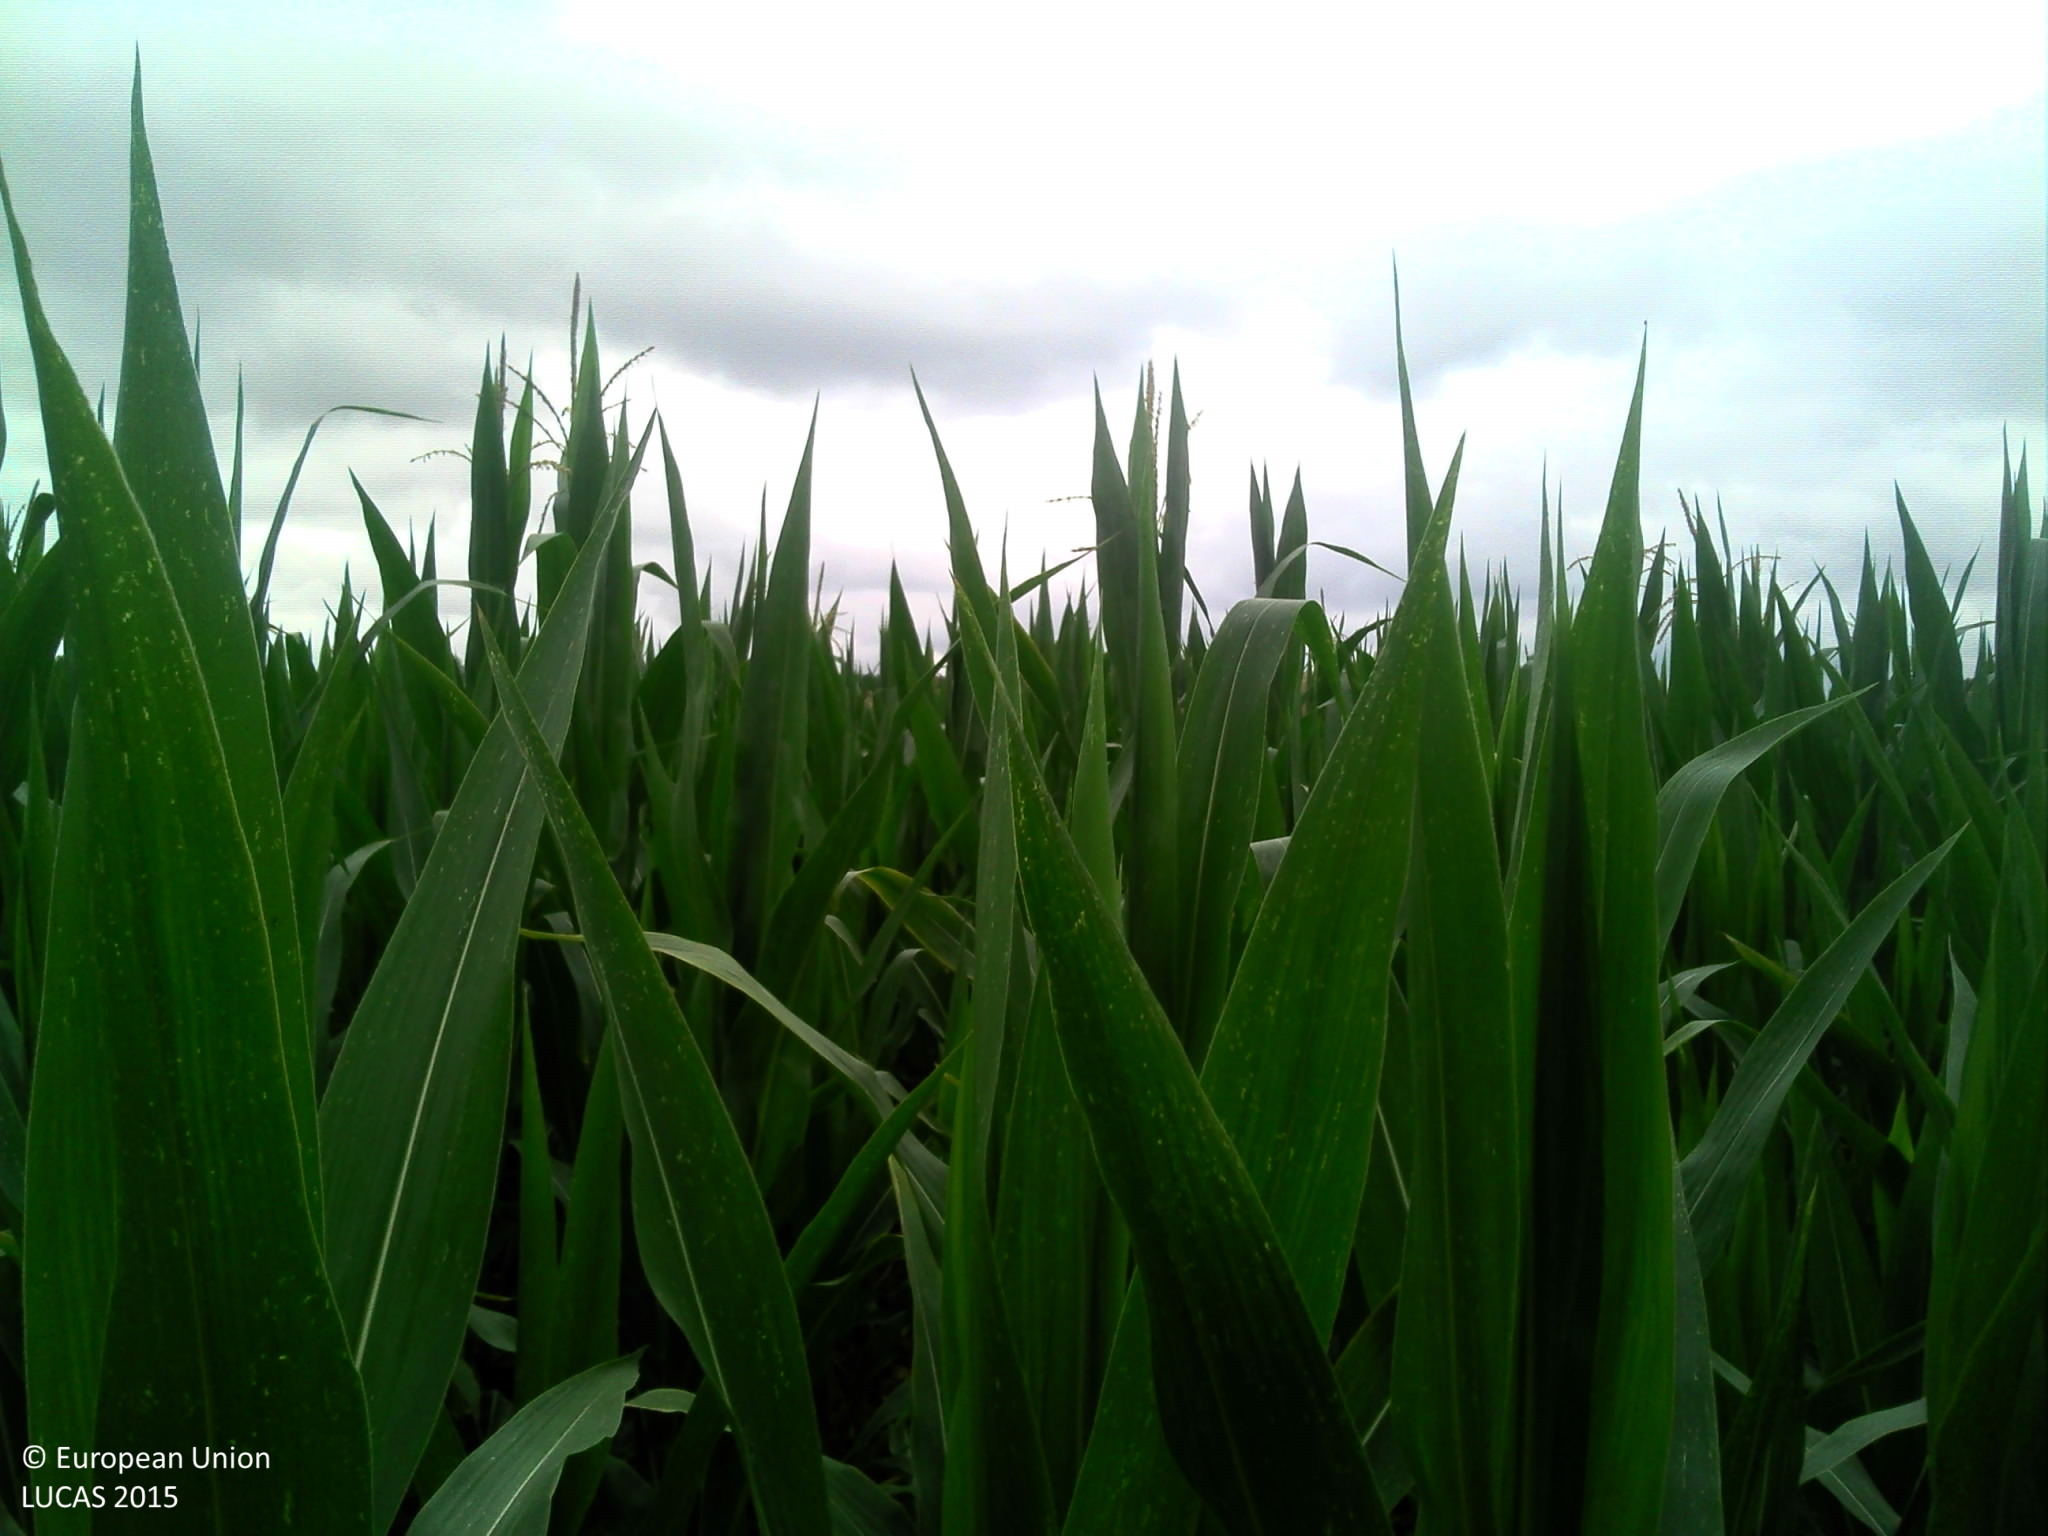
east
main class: Cropland
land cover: Maize
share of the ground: > 75 %
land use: Agriculture (excluding fallow land and kitchen gardens)
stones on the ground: < 10 %
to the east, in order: Maize; Managed hedges; Maize; Managed hedges; Maize
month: July
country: FR
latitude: 43.2559
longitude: 0.8494
